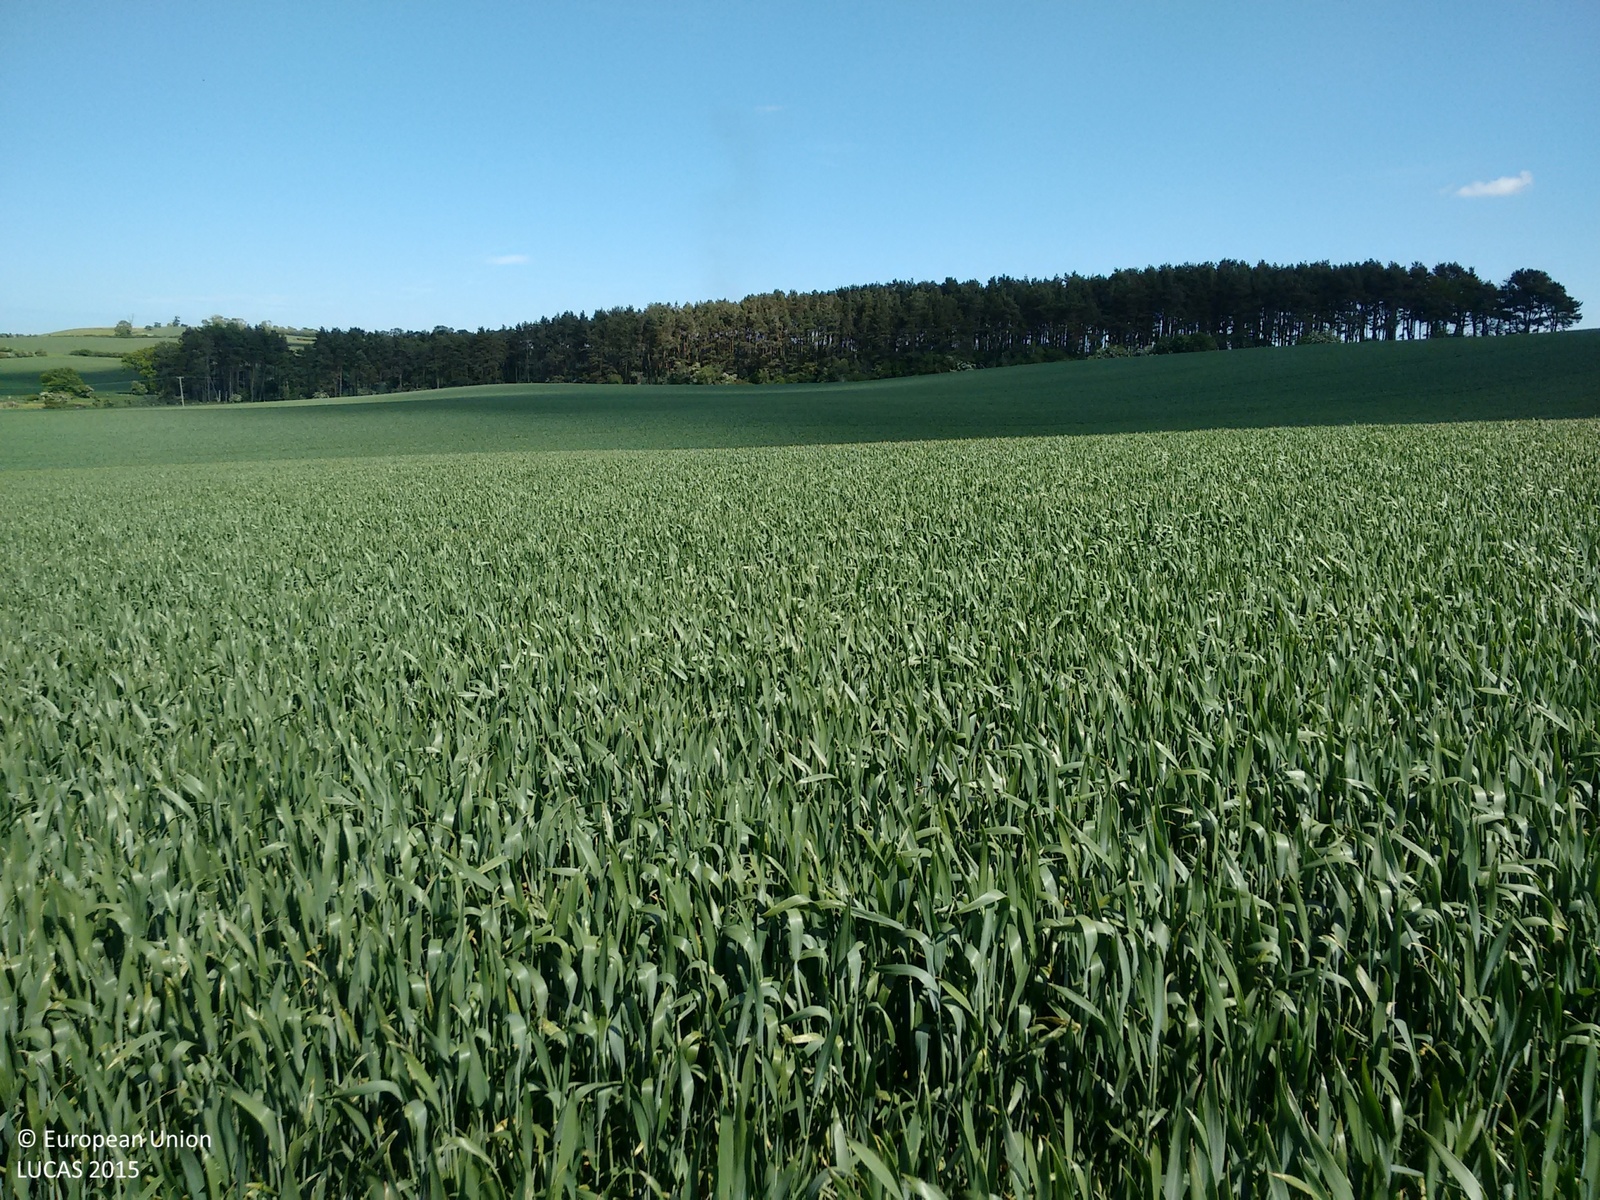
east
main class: Cropland
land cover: Common wheat
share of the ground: > 75 %
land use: Agriculture (excluding fallow land and kitchen gardens)
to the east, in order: Common wheat
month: June
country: GB
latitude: 55.6683
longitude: -2.0891
